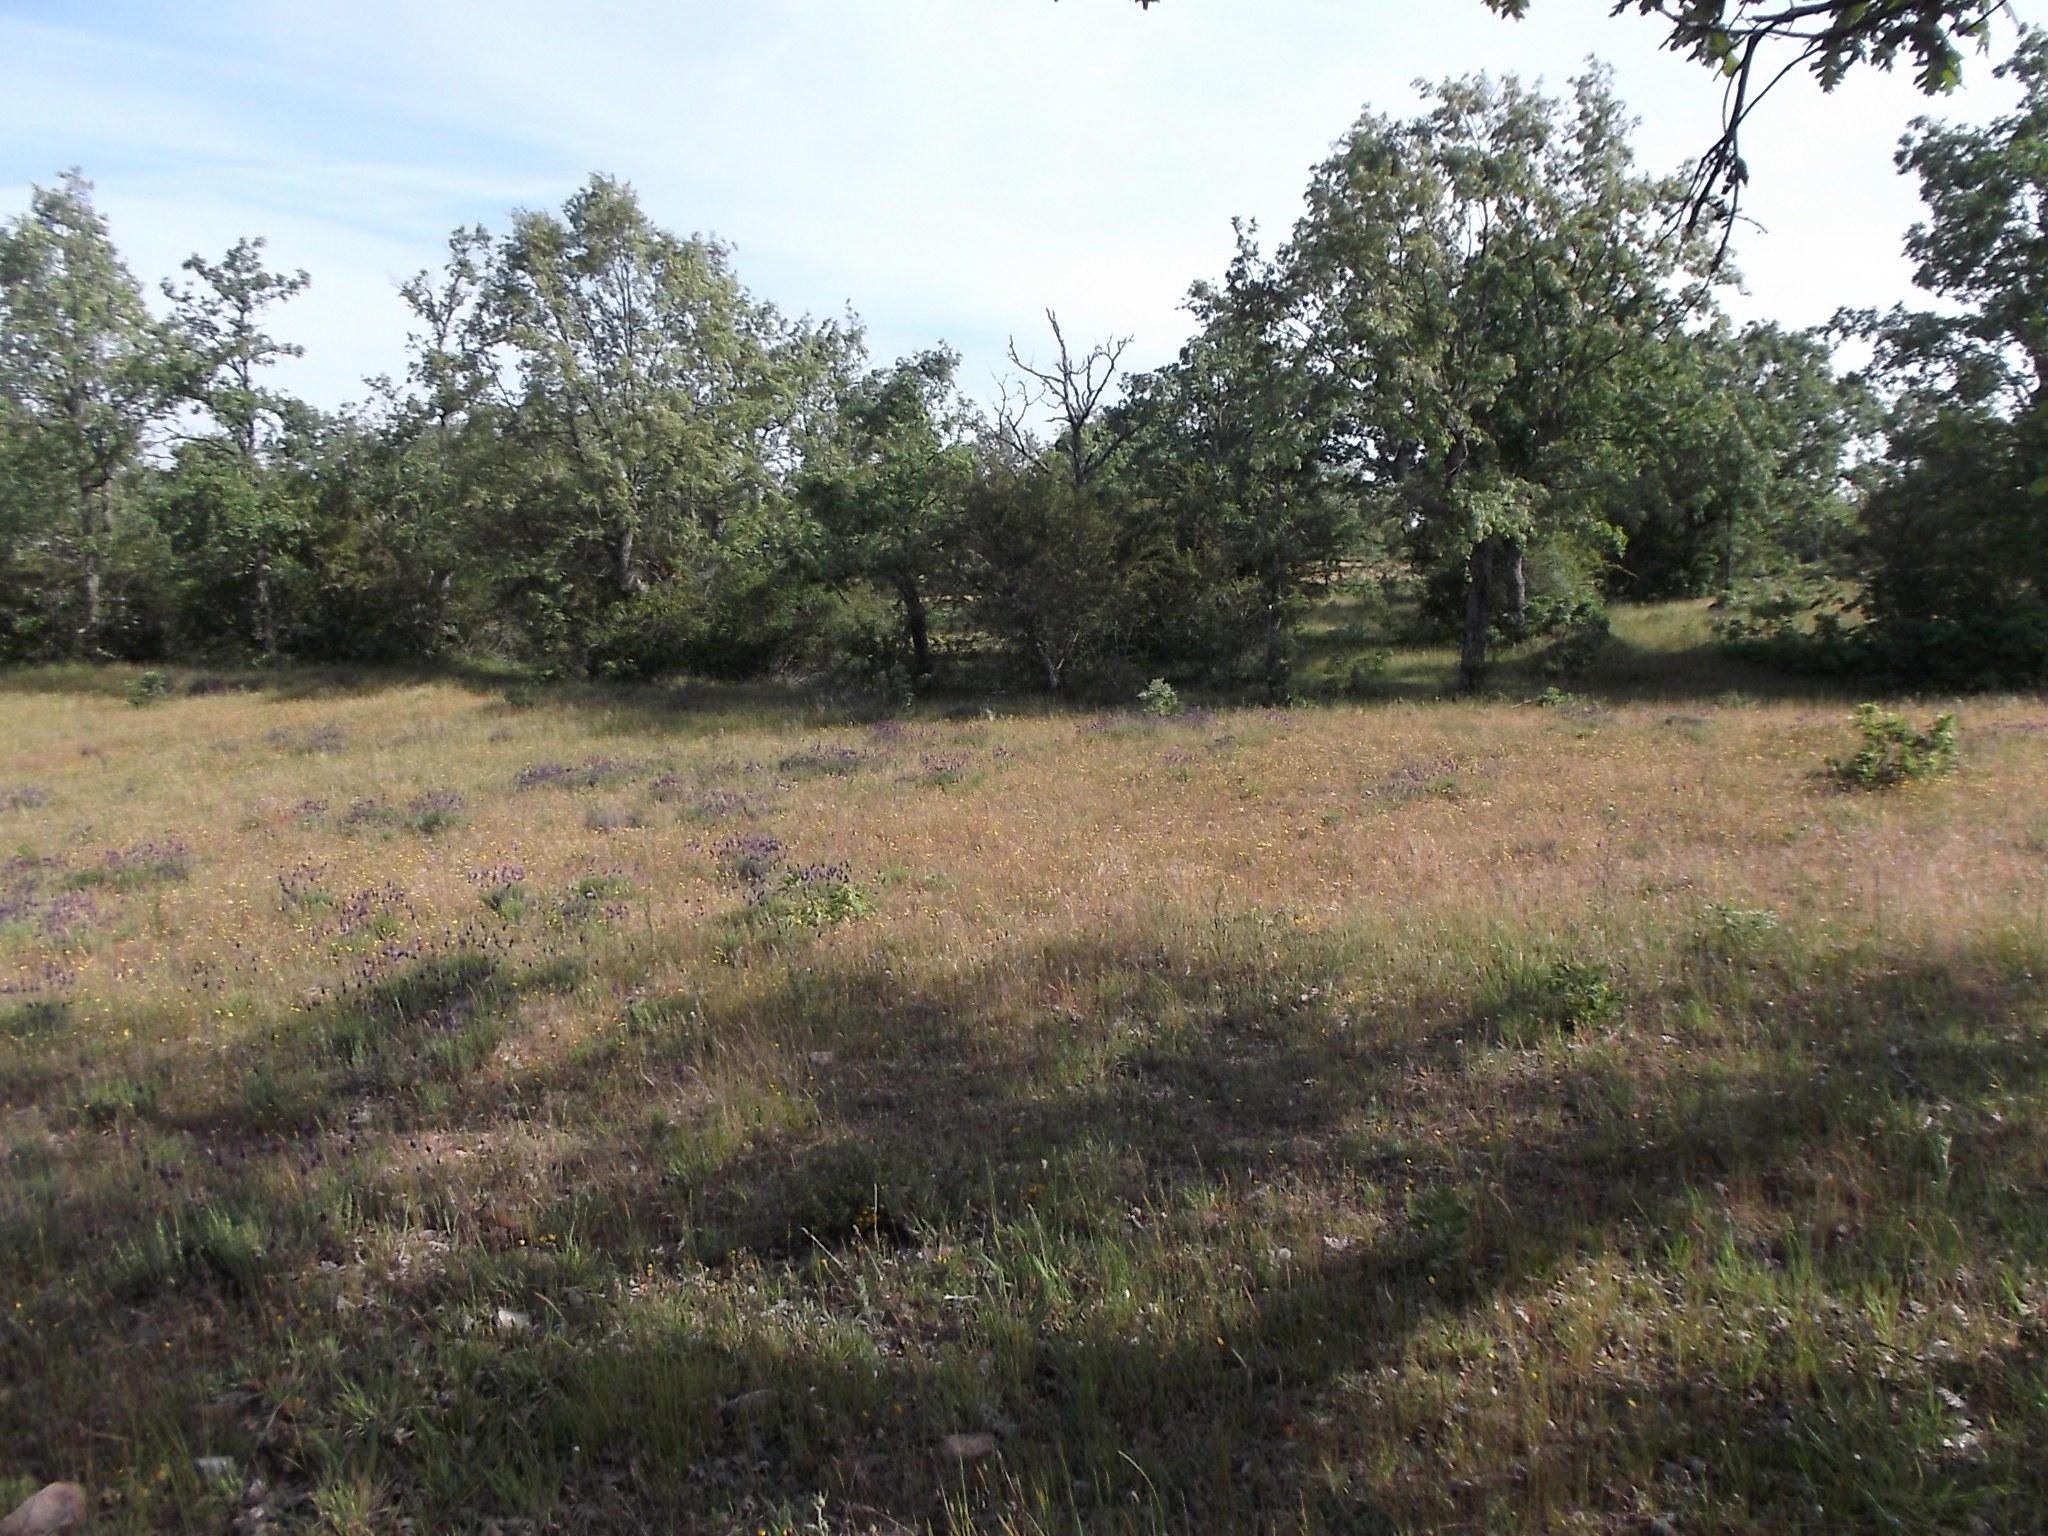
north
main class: Grassland
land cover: Grassland with sparse tree/shrub cover
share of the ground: > 75 %
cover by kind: herbaceous plants 90 %, broadleaved forest trees 5 %, shrubs 5 %
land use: Agriculture (excluding fallow land and kitchen gardens)
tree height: > 5 m
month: May
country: ES
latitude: 40.9894
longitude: -6.3163
